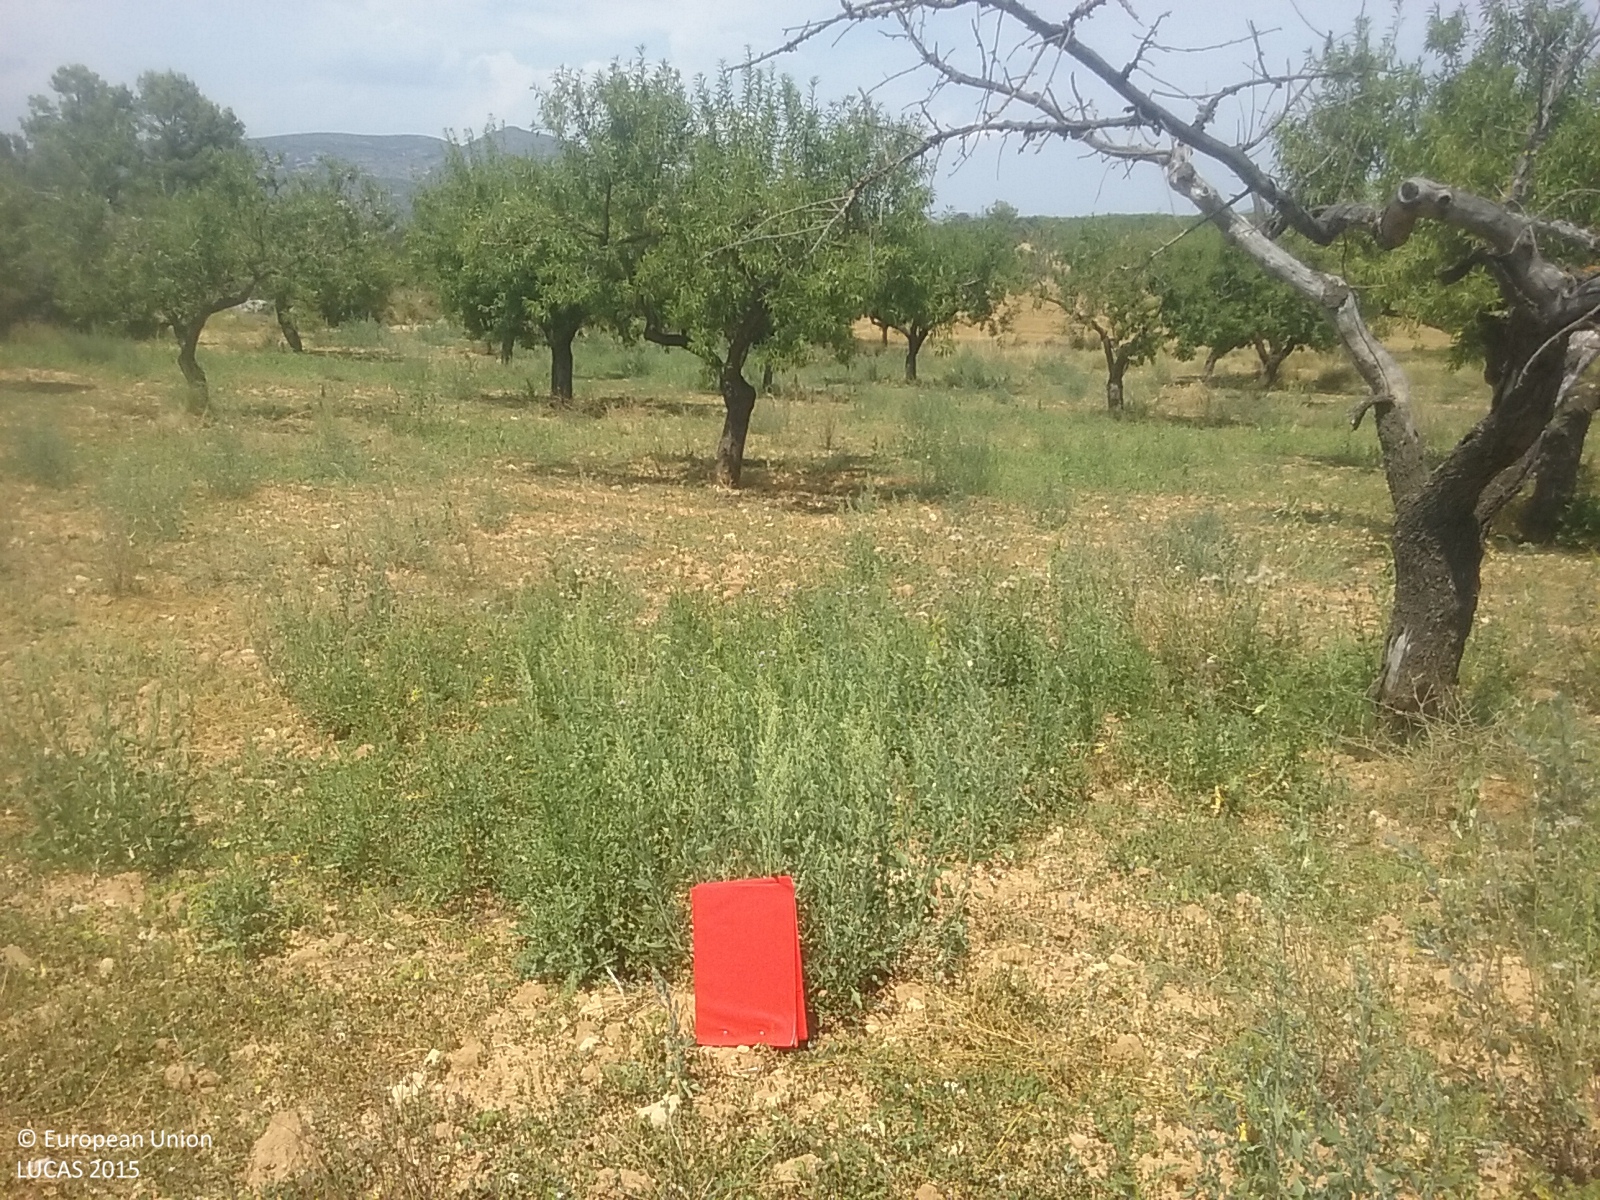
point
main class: Cropland
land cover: Nuts trees
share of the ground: 25 - 50 %
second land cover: Spontaneously vegetated surfaces
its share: 50 - 75 %
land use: Agriculture (excluding fallow land and kitchen gardens)
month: July
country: ES
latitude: 40.3359
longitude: -0.0215
